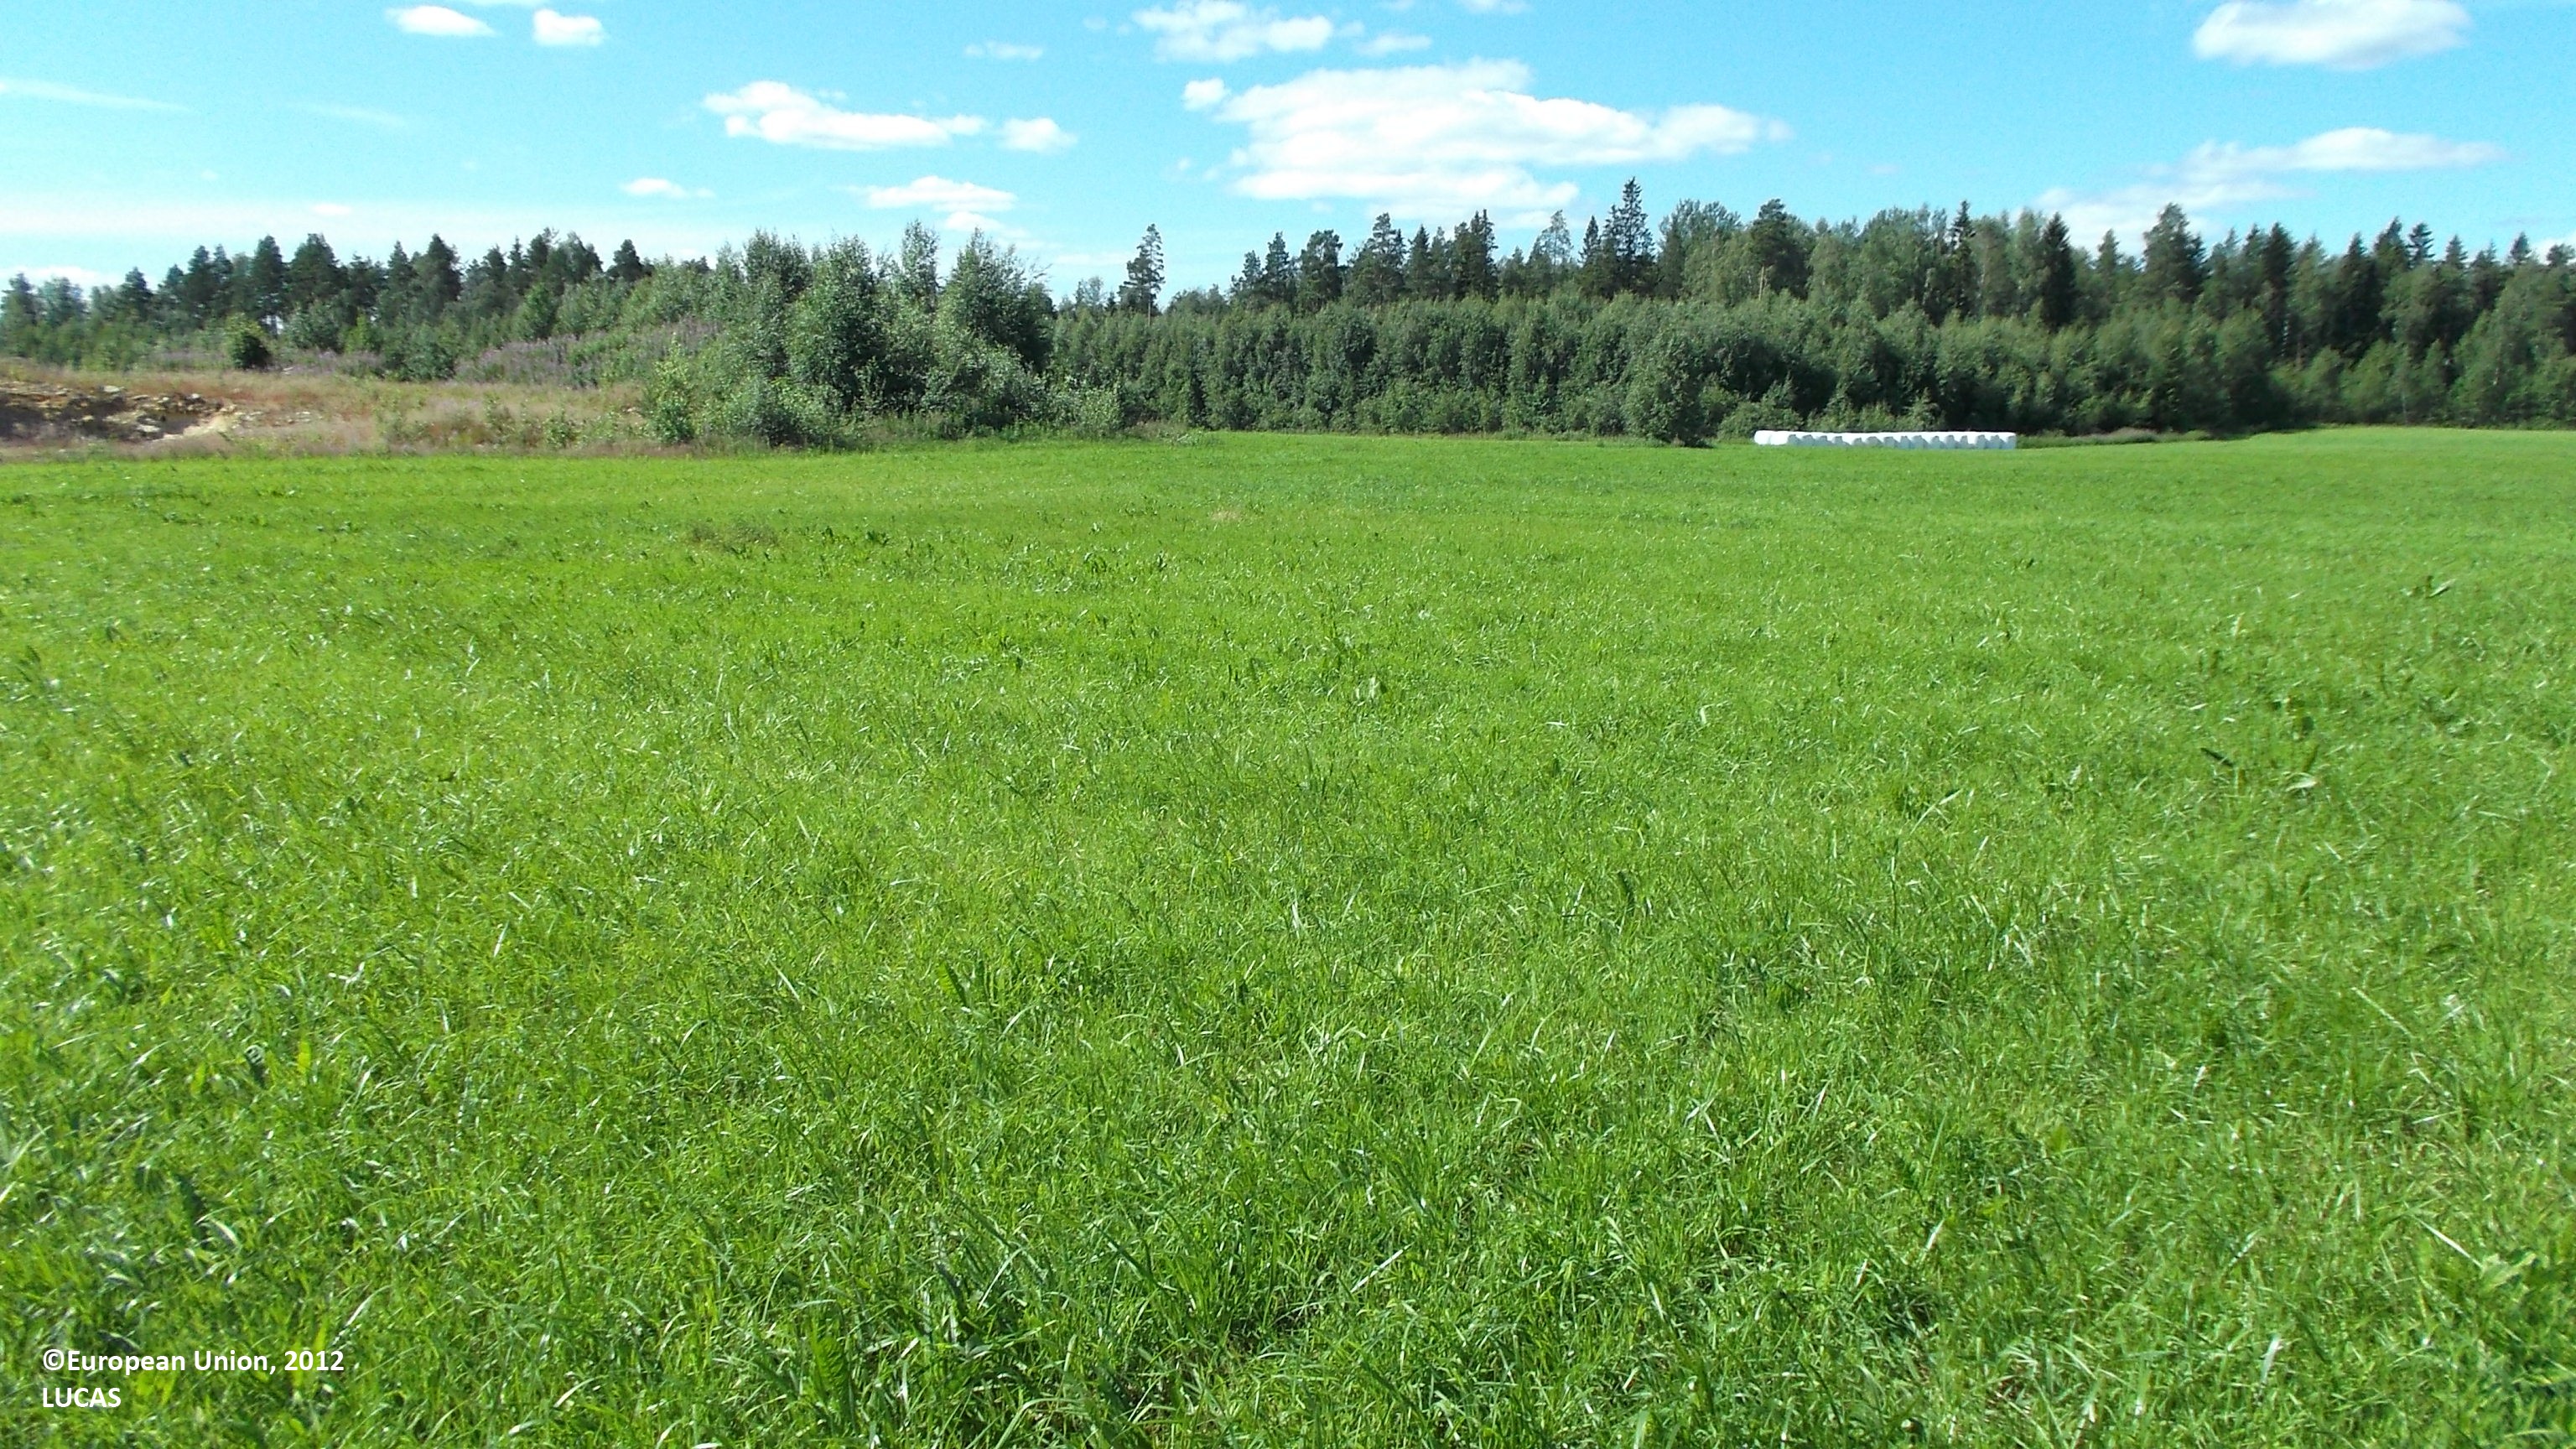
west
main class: Cropland
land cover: Temporary grasslands
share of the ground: > 75 %
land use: Agriculture (excluding fallow land and kitchen gardens)
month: July
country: FI
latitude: 63.6289
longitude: 23.9719
